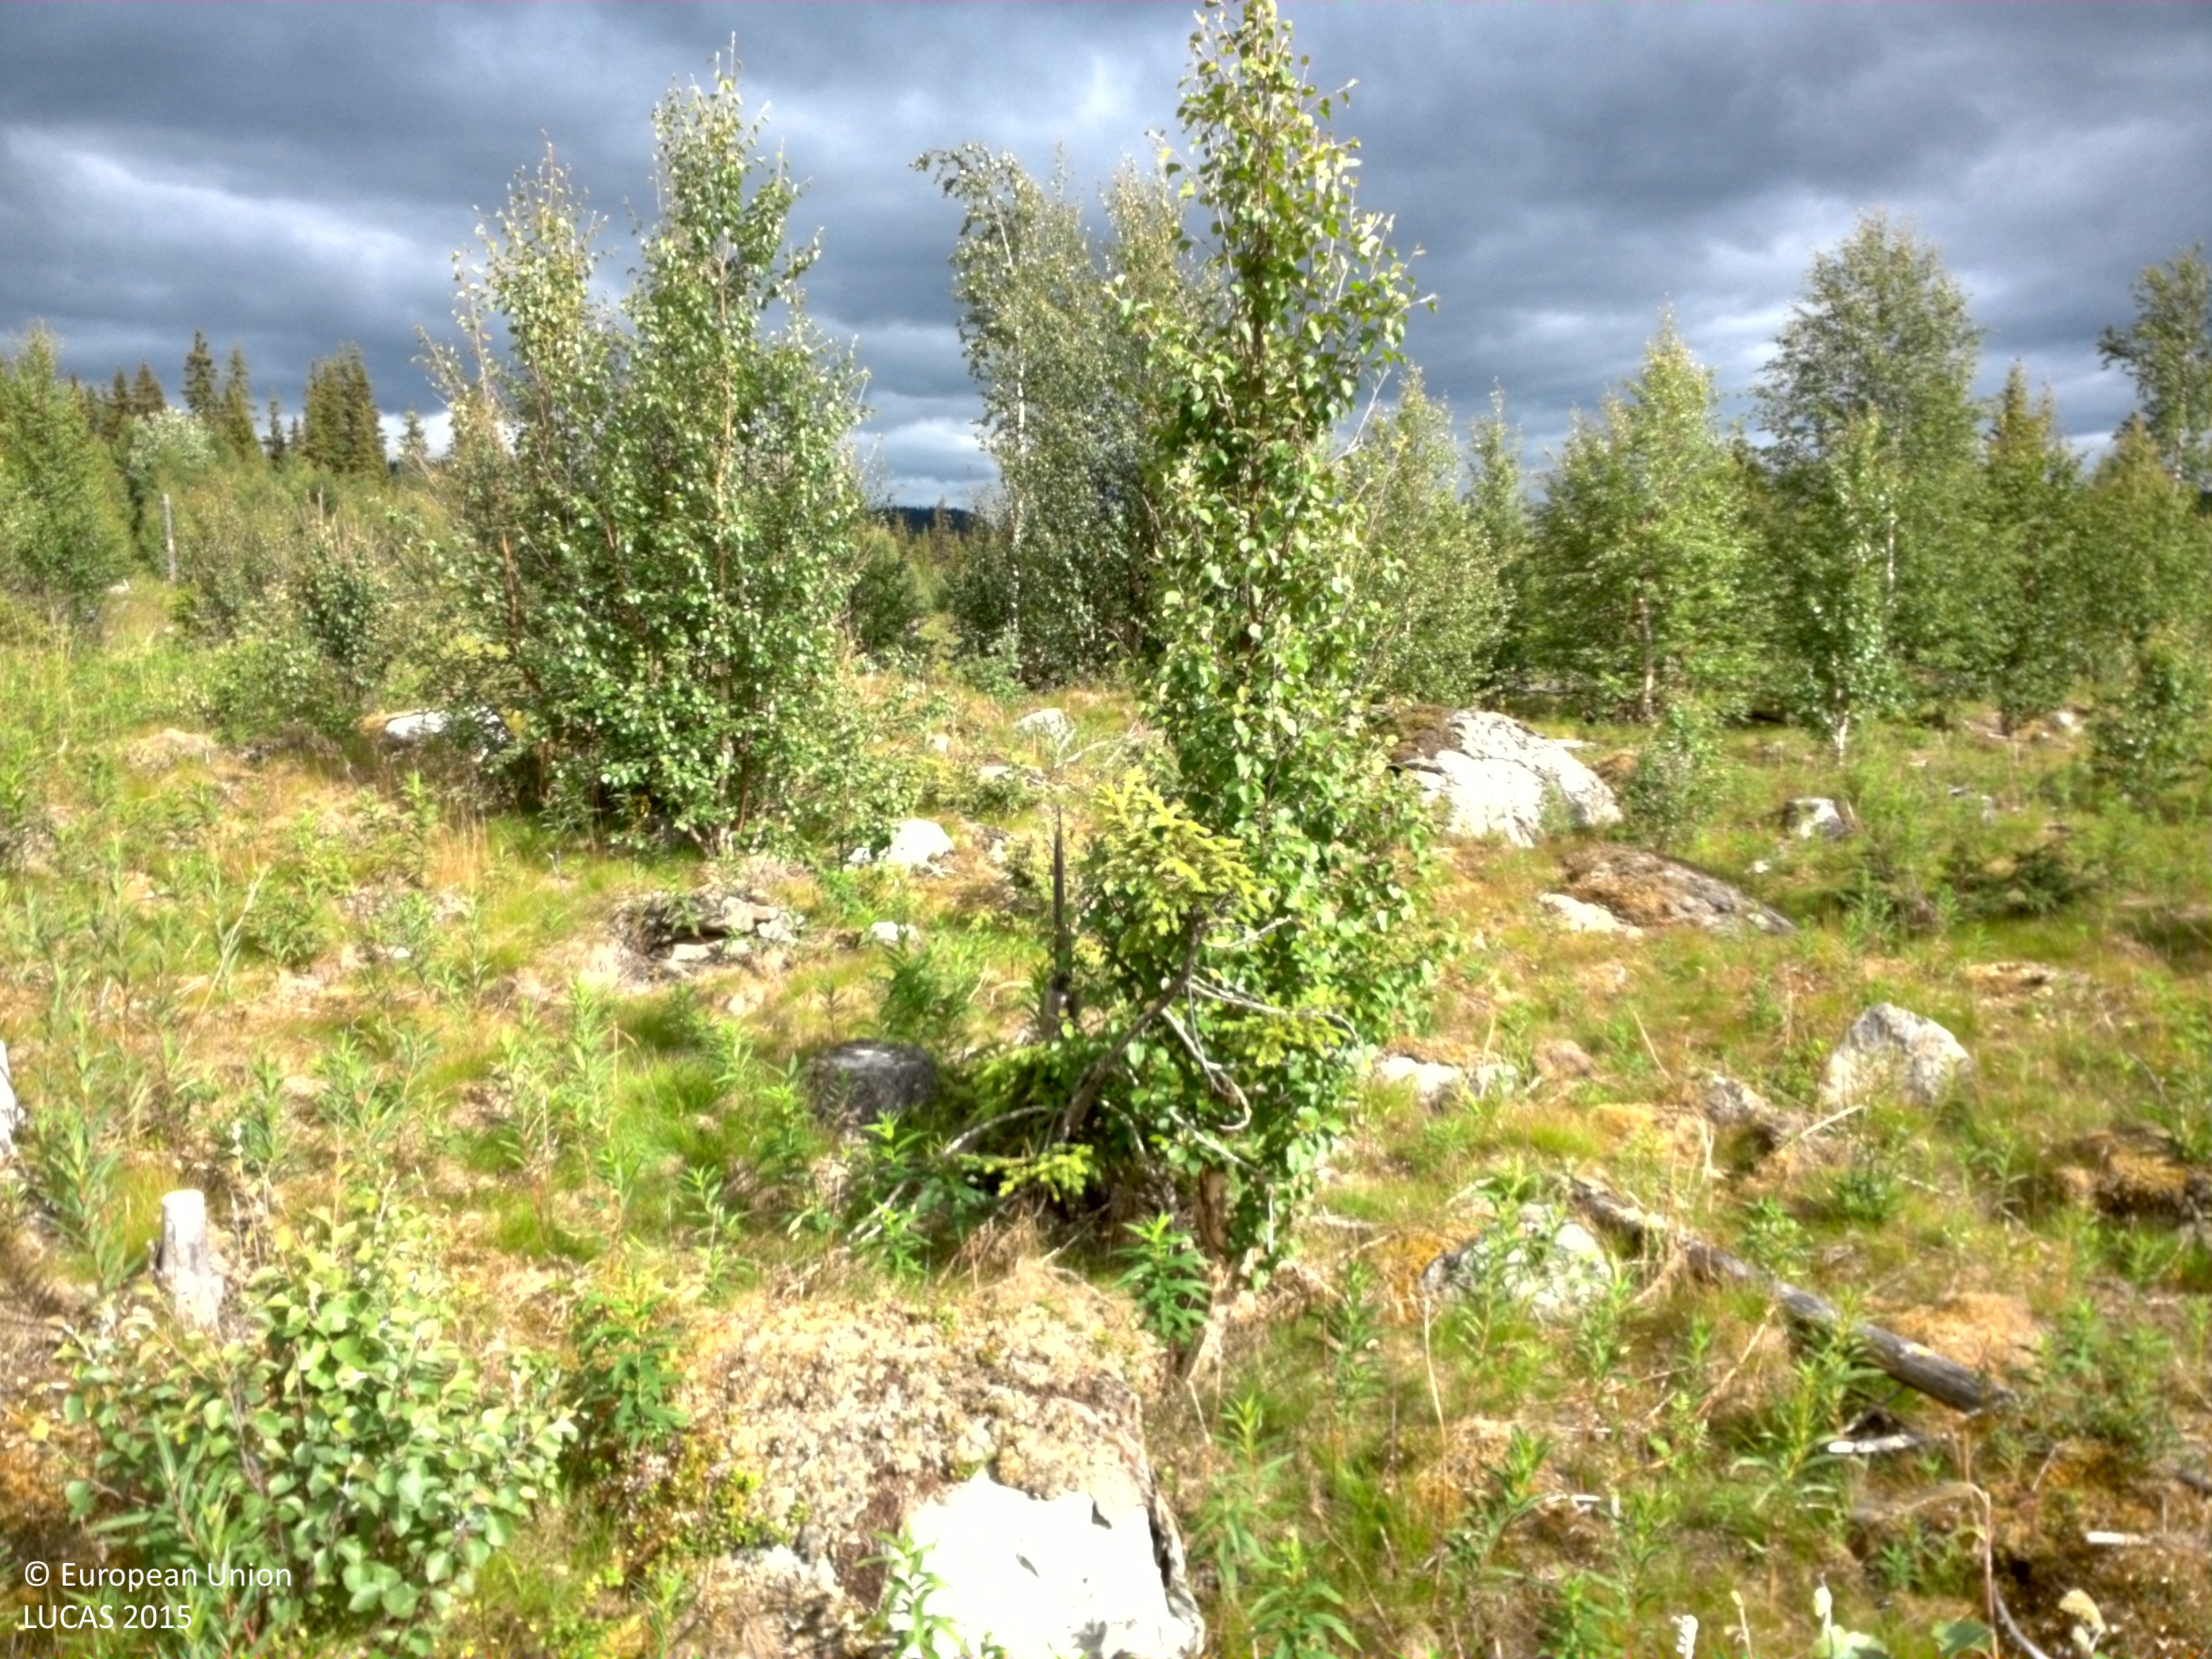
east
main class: Woodland
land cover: Broadleaved woodland
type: non-riverine alder, birch or aspen forest
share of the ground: 10 - 25 %
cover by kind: herbaceous plants 60 %, lichens and mosses 20 %, broadleaved forest trees 10 %, shrubs 10 %
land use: Forestry
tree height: < 5 m
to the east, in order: Broadleaved woodland; Grassland with sparse tree/shrub cover; Broadleaved woodland; Tracks; Broadleaved woodland; Spruce dominated coniferous woodland; Spruce dominated mixed woodland
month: August
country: SE
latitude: 65.2325
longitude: 15.8480
